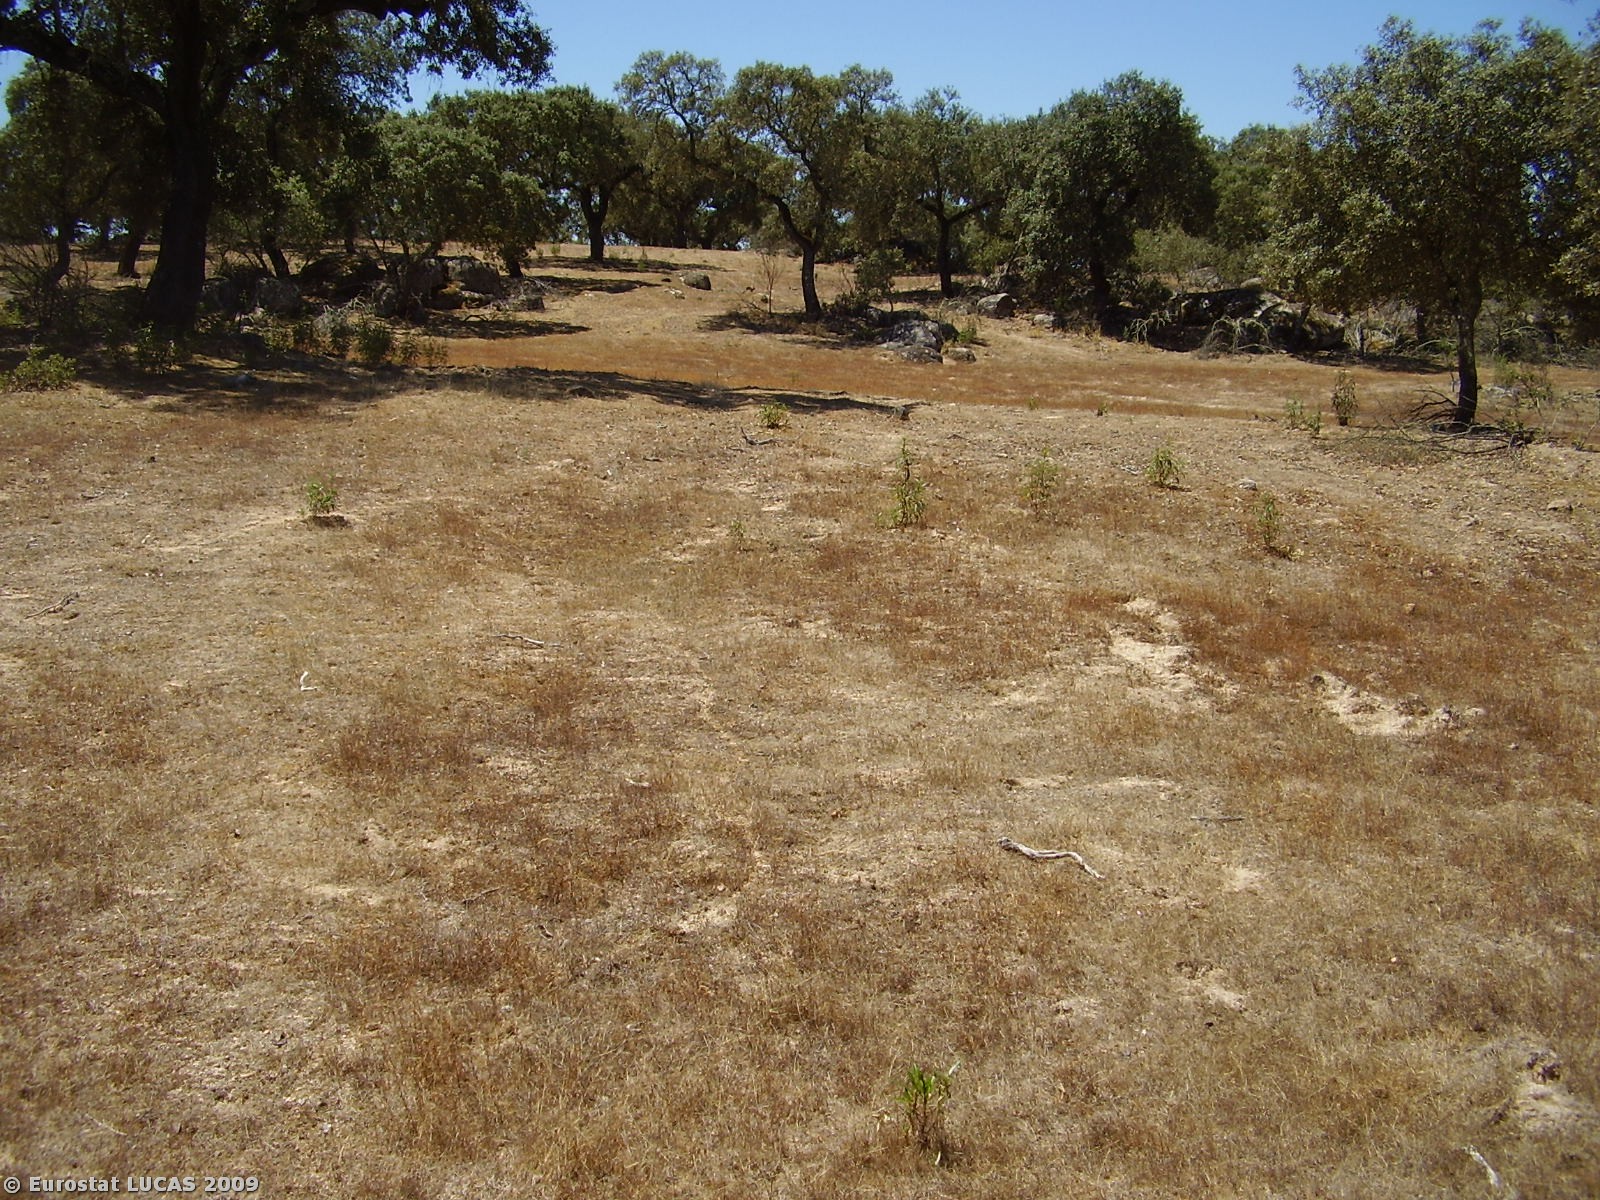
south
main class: Woodland
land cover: Broadleaved woodland
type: broadleaved evergreen forest
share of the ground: 10 - 25 %
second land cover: Grassland with sparse tree/shrub cover
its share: 50 - 75 %
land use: Forestry
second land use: Agriculture (excluding fallow land and kitchen gardens)
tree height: > 5 m
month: July
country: PT
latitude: 38.8743
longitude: -7.9466
